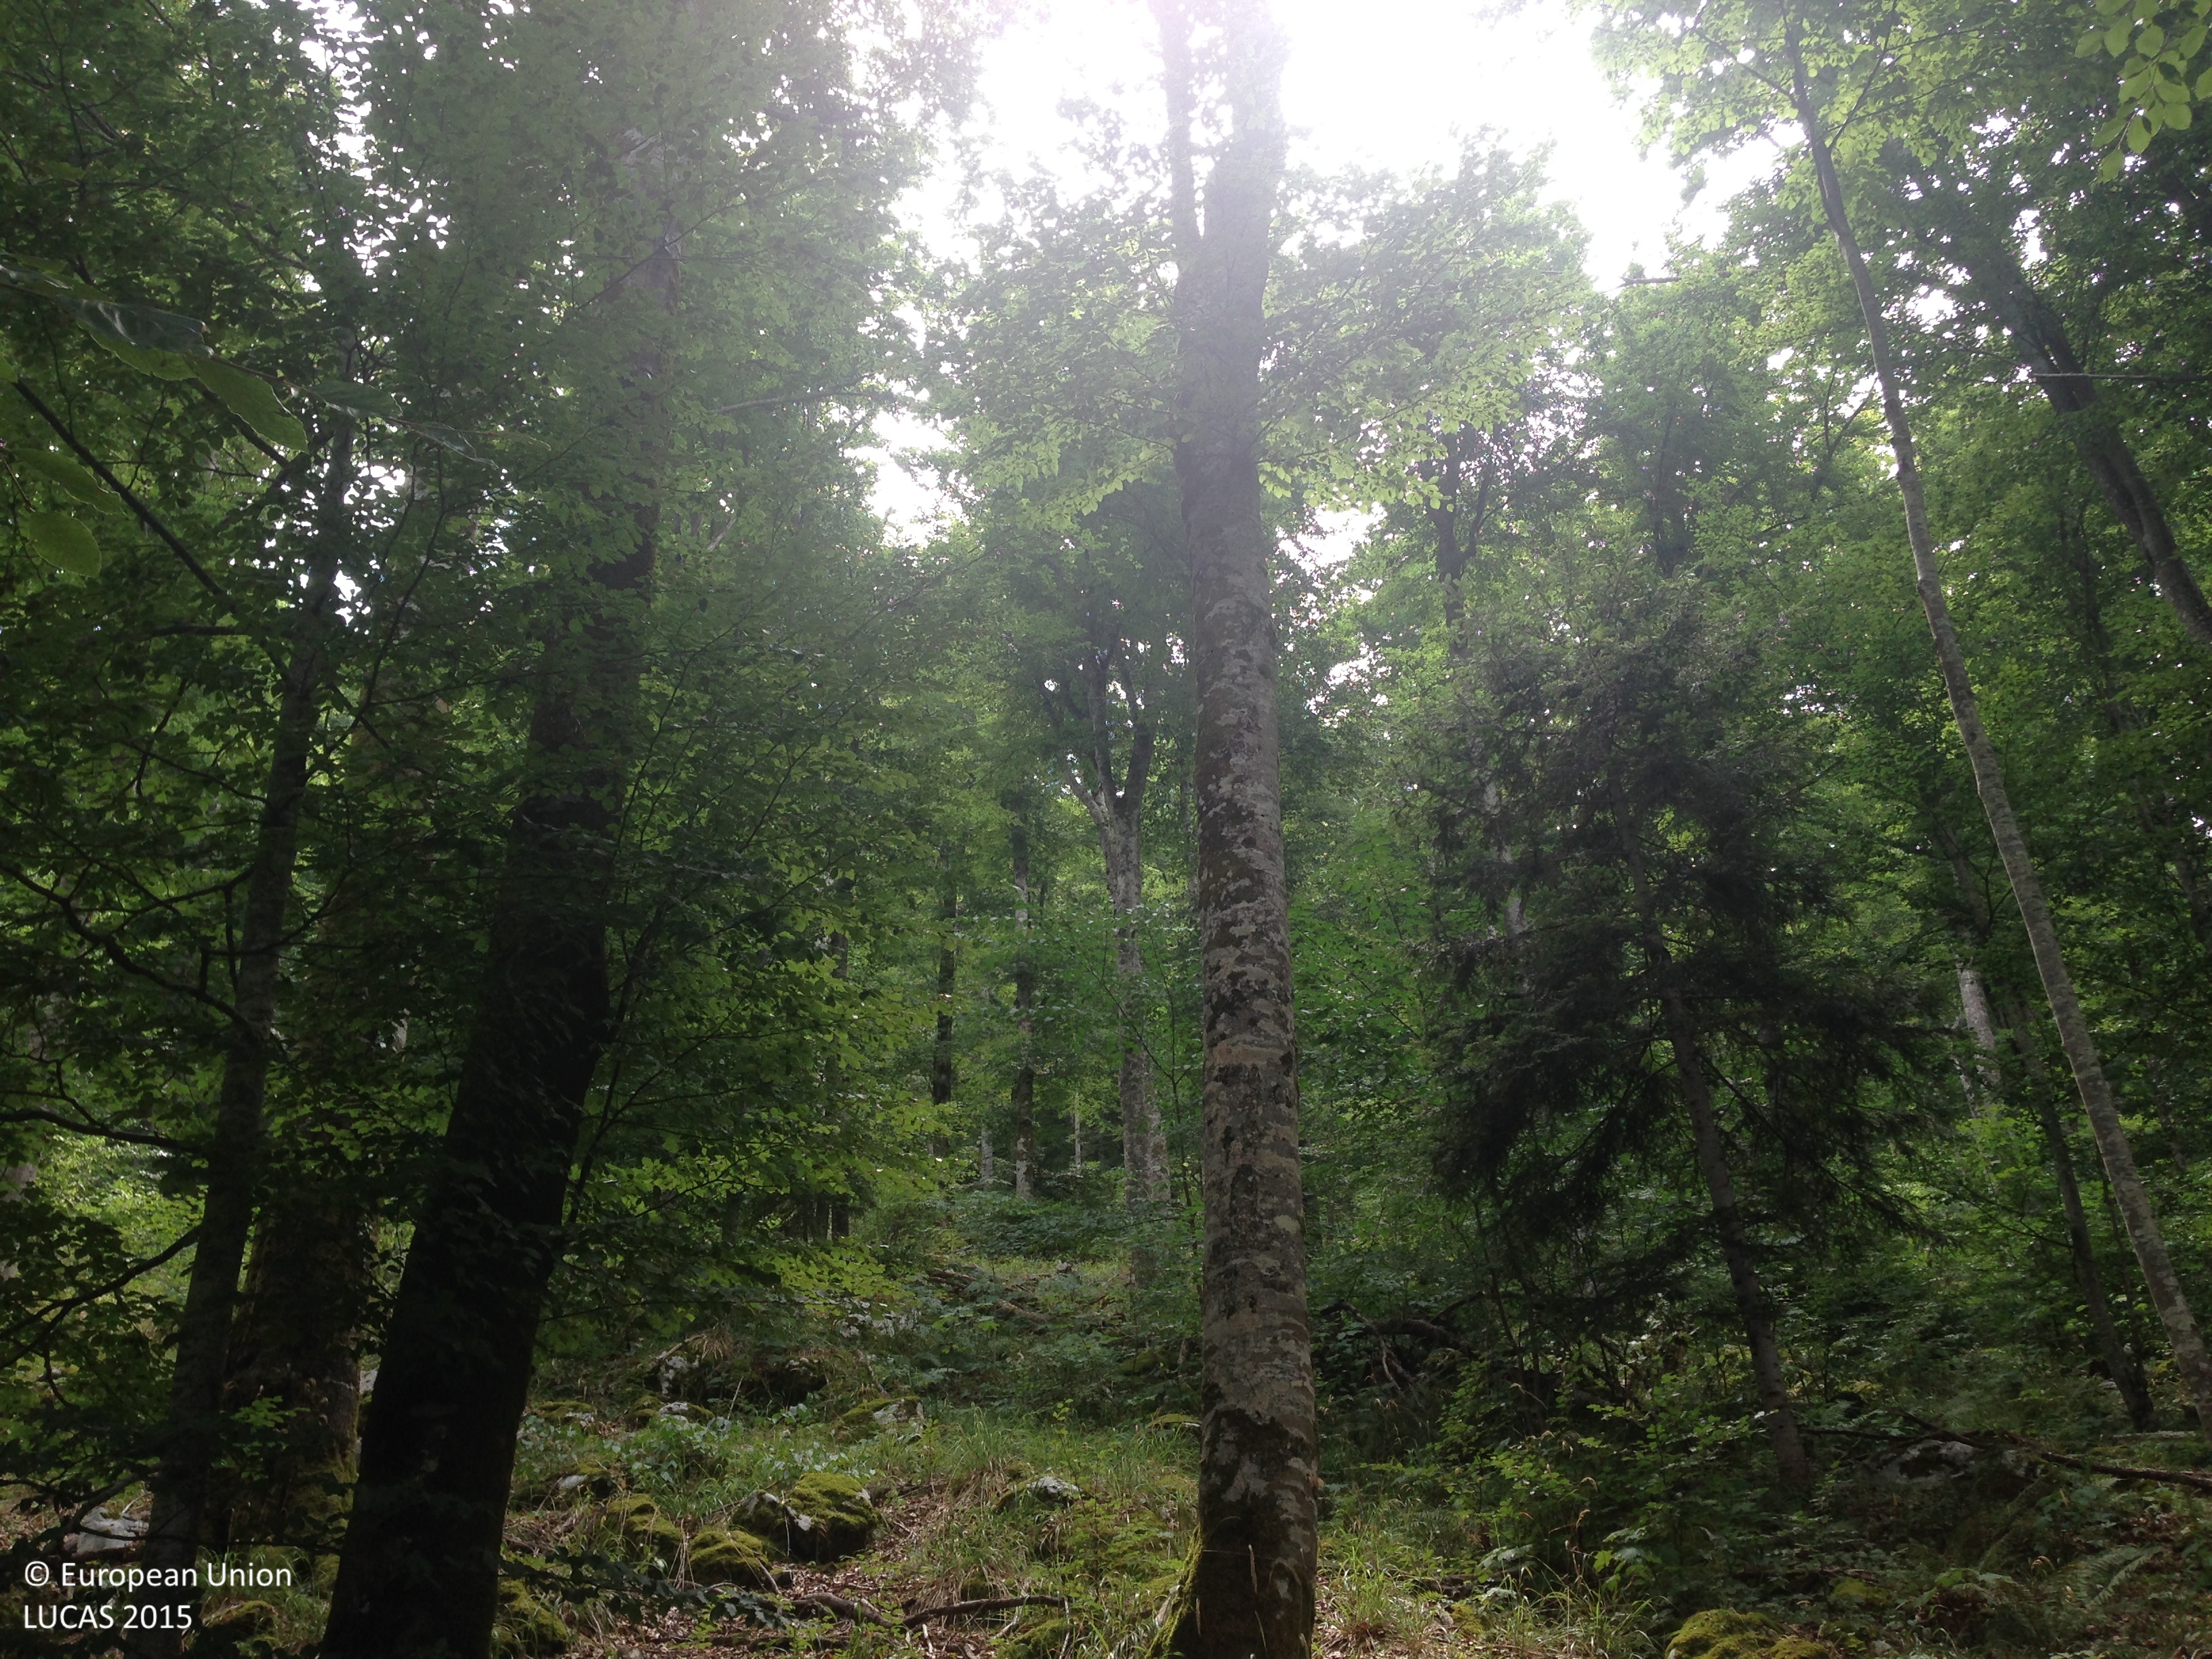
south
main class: Woodland
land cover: Other mixed woodland
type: thermophilous deciduous forest
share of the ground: > 75 %
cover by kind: broadleaved forest trees 55 %, coniferous forest trees 45 %
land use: Forestry
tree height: > 5 m
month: July
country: HR
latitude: 44.7964
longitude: 15.2401
